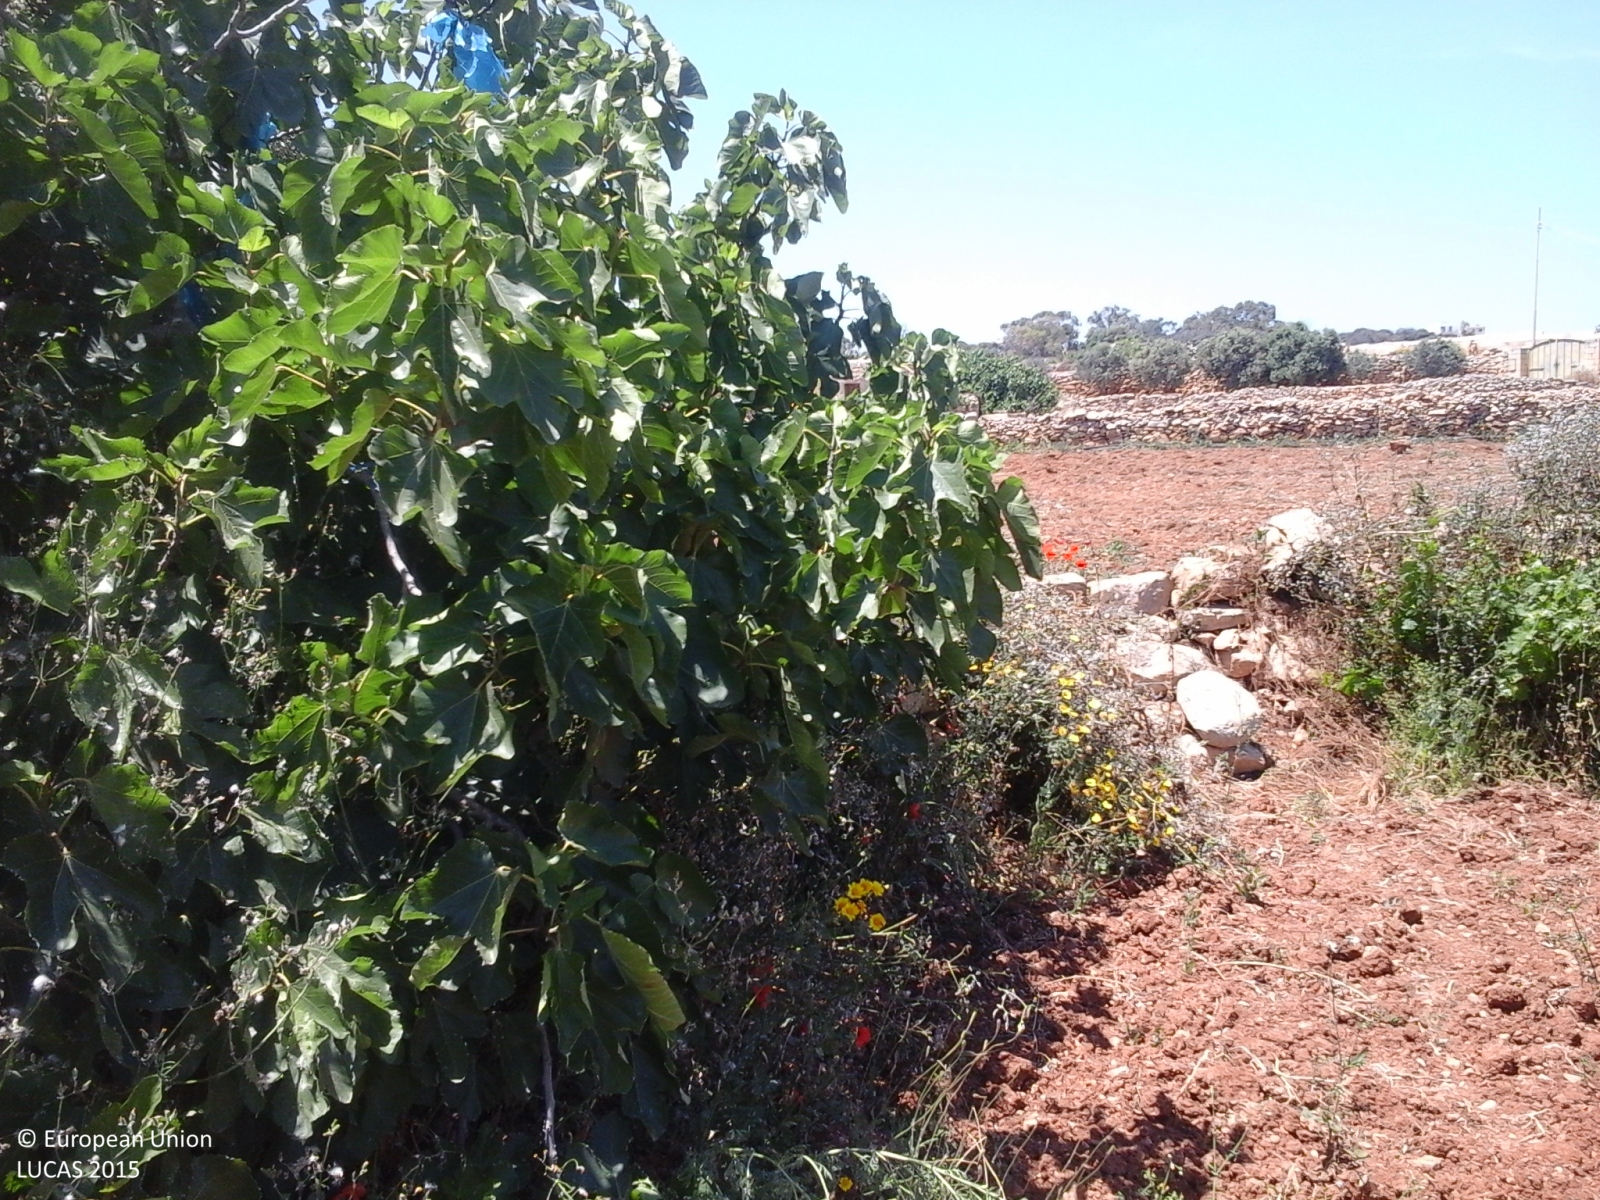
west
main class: Cropland
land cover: Olive groves
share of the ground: 10 - 25 %
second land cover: Spontaneously vegetated surfaces
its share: 10 - 25 %
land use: Agriculture (excluding fallow land and kitchen gardens)
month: May
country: MT
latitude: 35.8218
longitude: 14.4852
